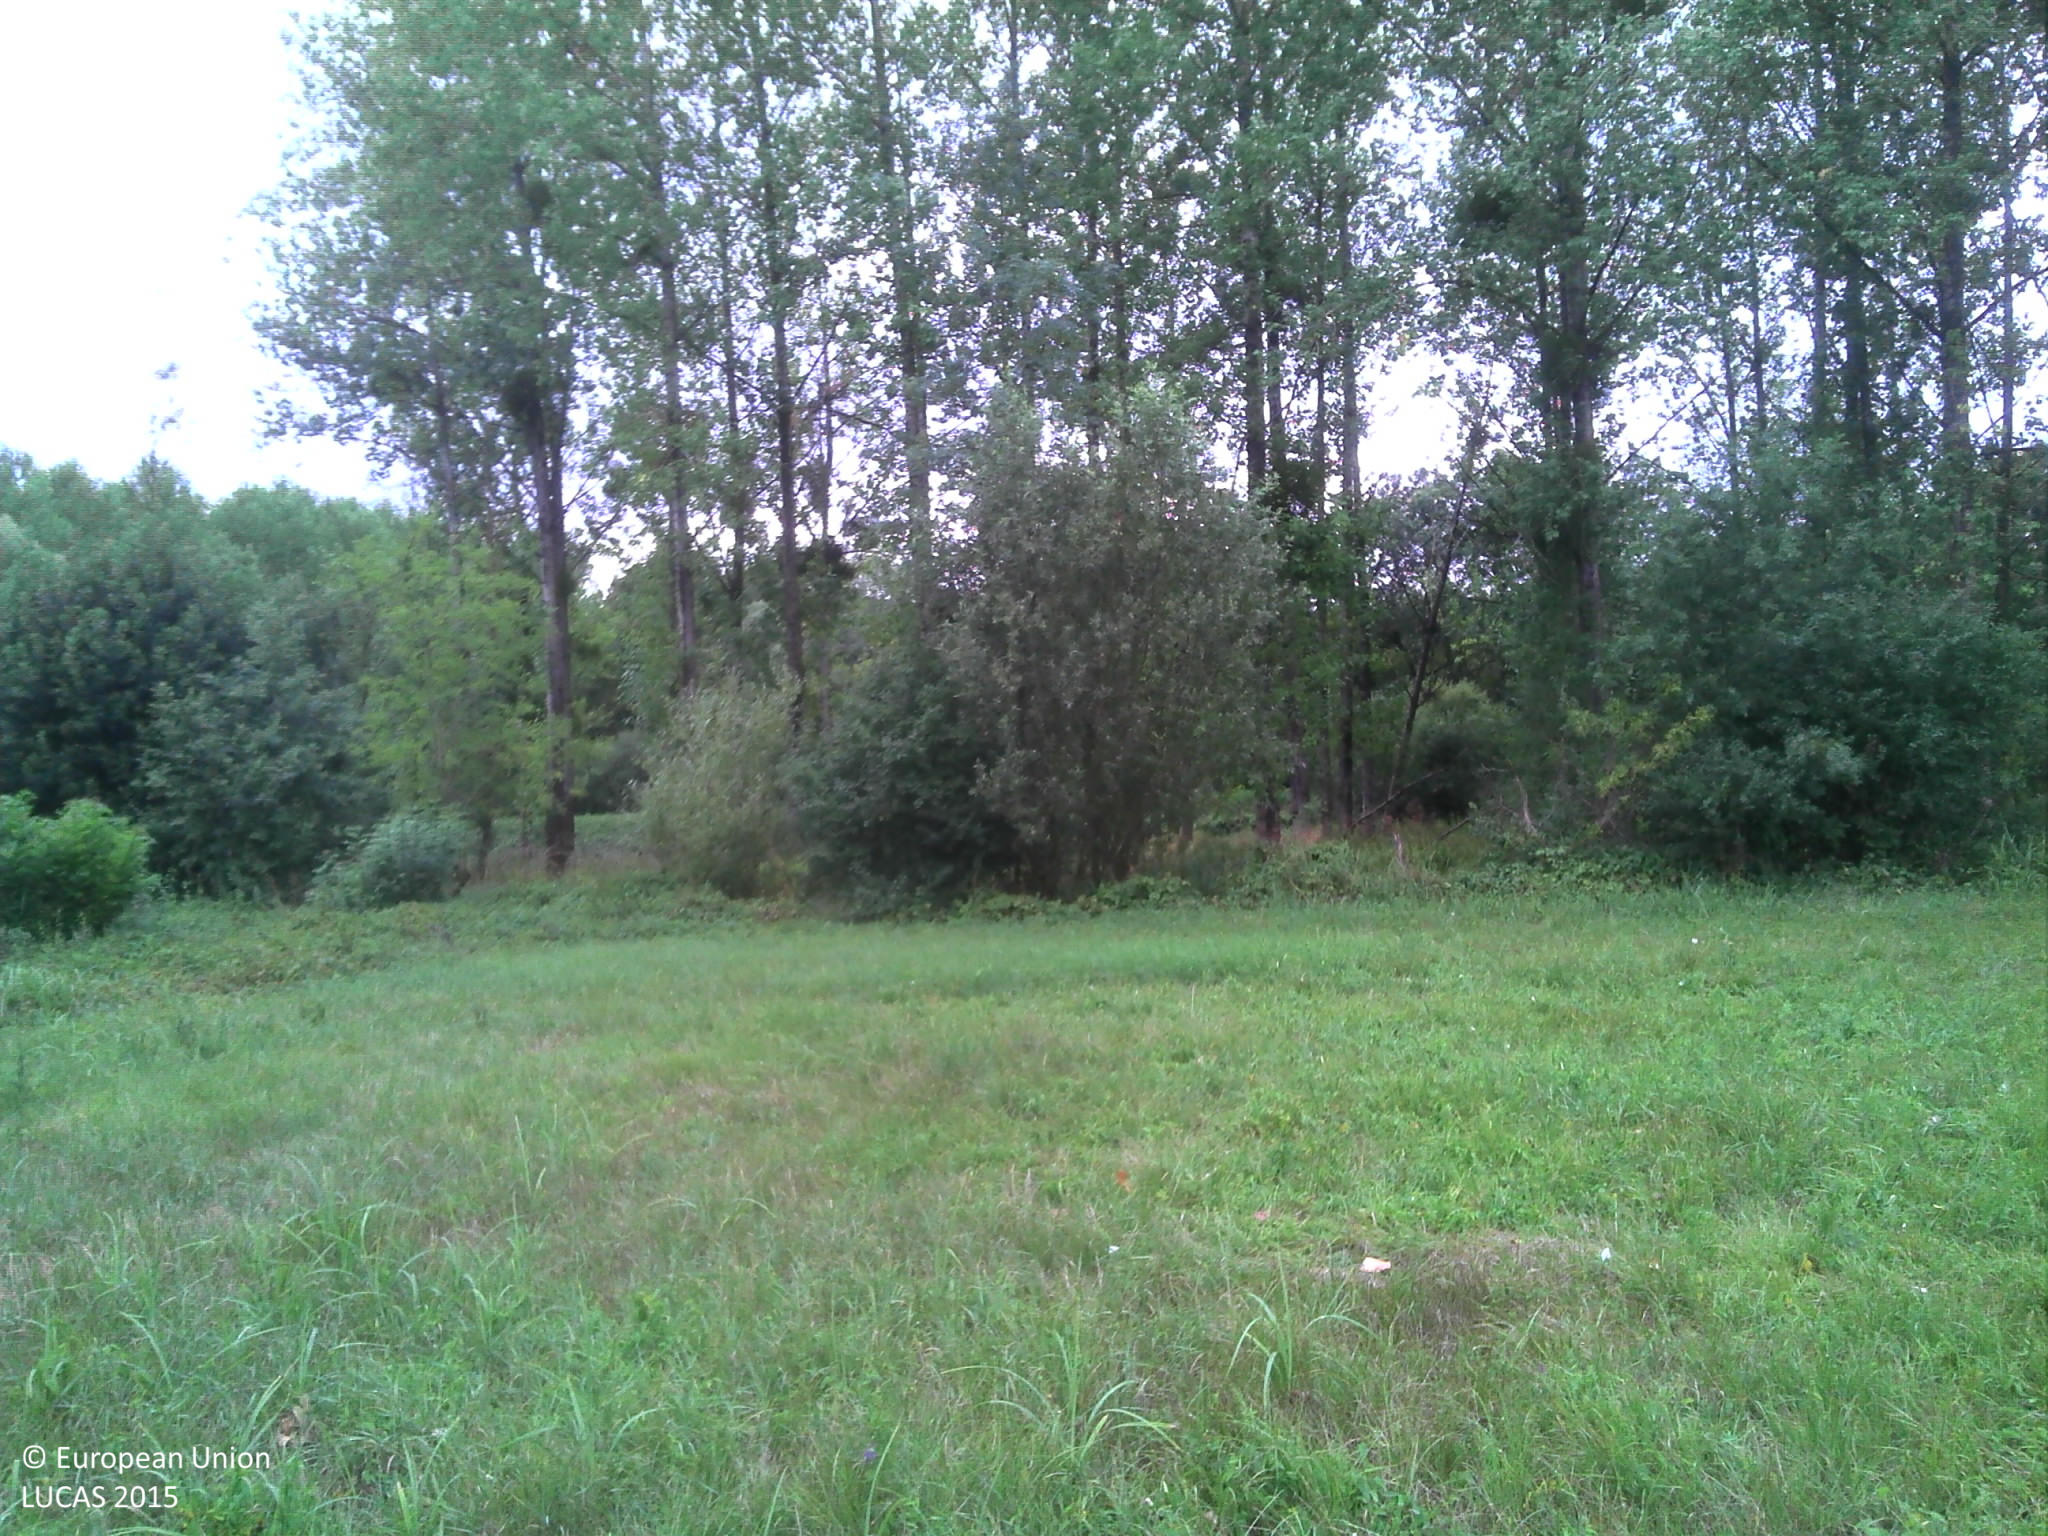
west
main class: Grassland
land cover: Grassland without tree/shrub cover
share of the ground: > 75 %
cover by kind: herbaceous plants 100 %
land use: Agriculture (excluding fallow land and kitchen gardens)
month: July
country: FR
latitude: 46.6839
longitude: 4.9680
